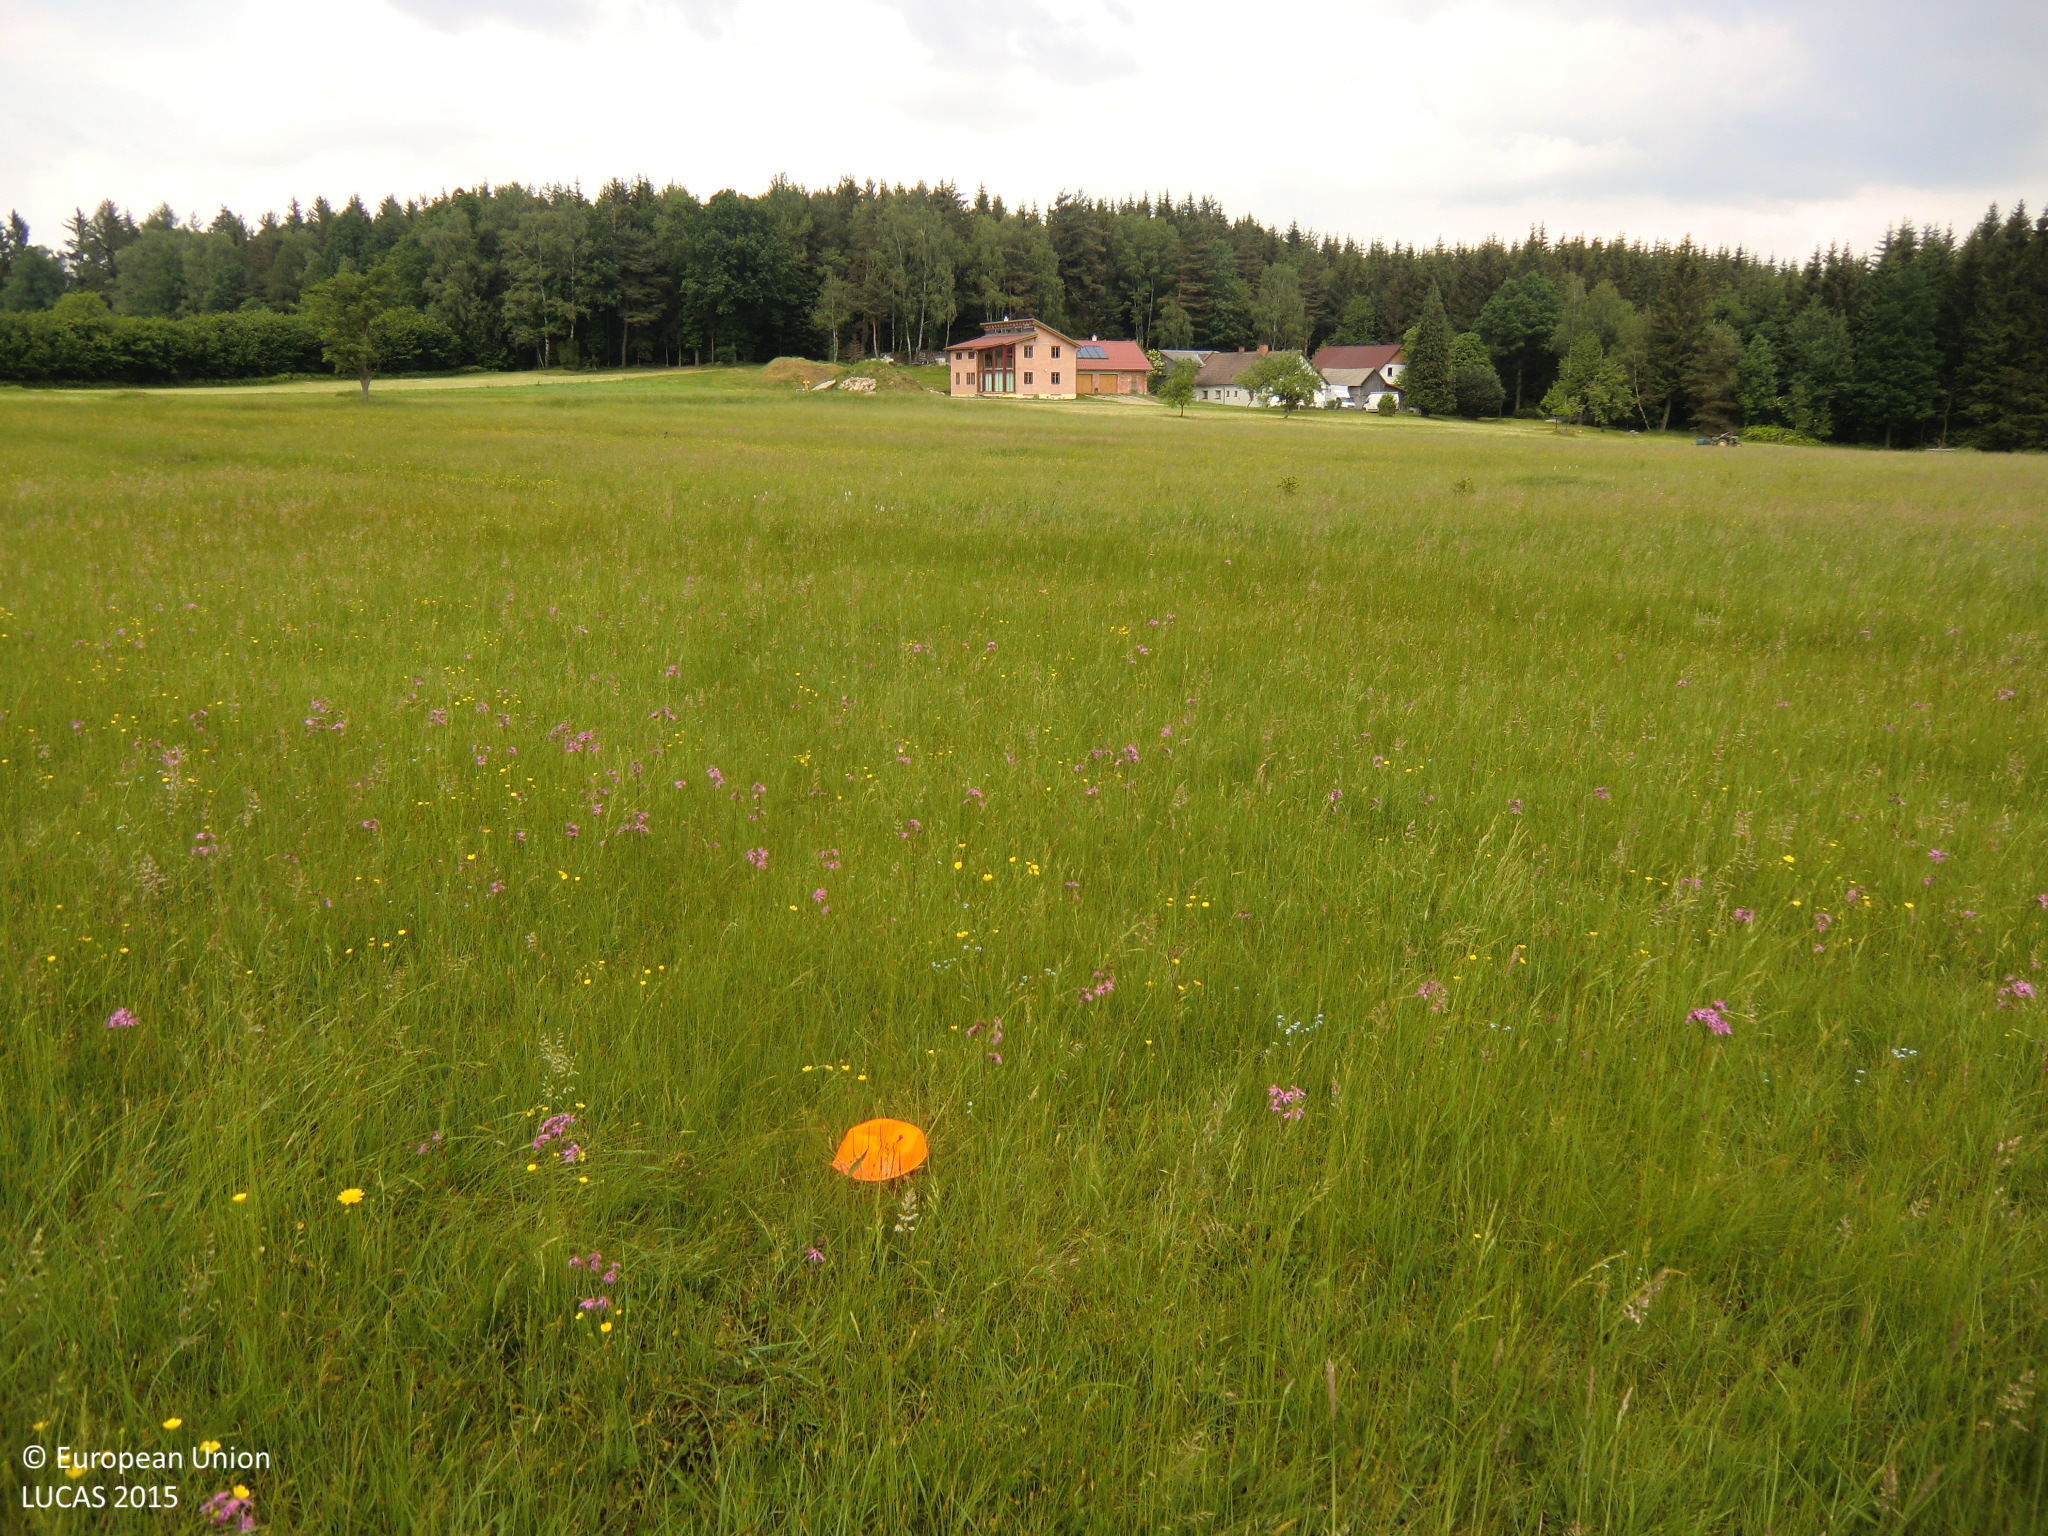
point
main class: Grassland
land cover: Grassland without tree/shrub cover
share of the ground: > 75 %
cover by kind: herbaceous plants 100 %
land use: Agriculture (excluding fallow land and kitchen gardens)
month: June
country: AT
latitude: 48.6959
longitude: 14.7973
